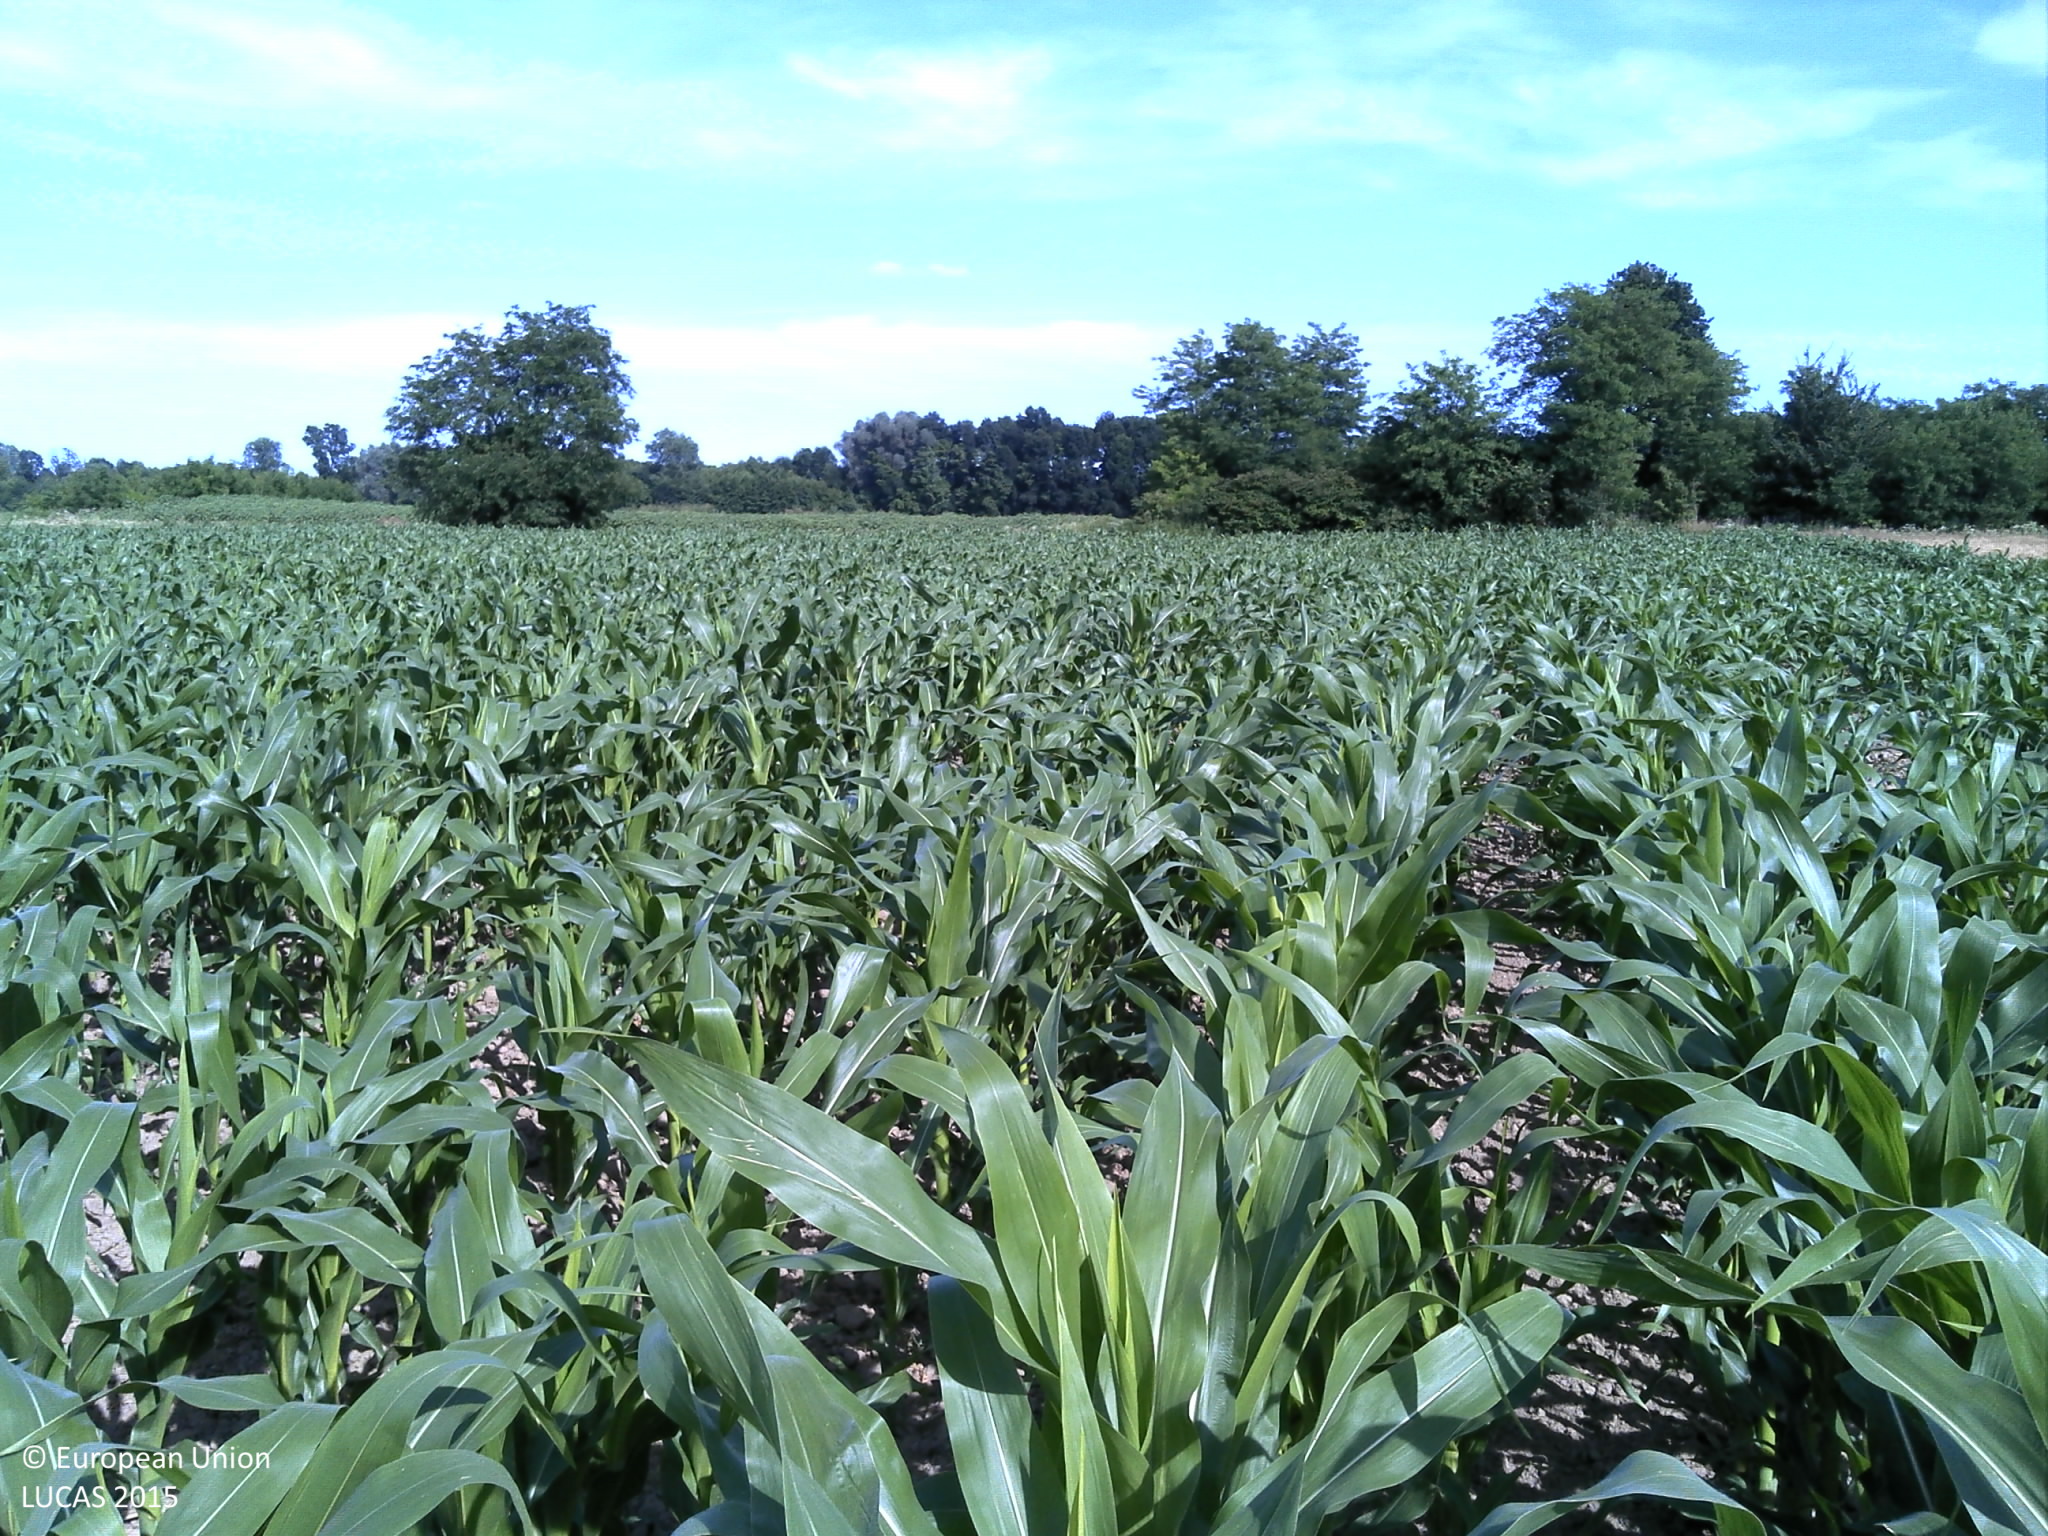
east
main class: Cropland
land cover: Maize
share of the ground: > 75 %
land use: Agriculture (excluding fallow land and kitchen gardens)
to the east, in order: Maize; Soya; Potatoes; Tracks; Ditches and canals; Common wheat; Clovers; Maize
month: June
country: HR
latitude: 45.9037
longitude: 17.5438
